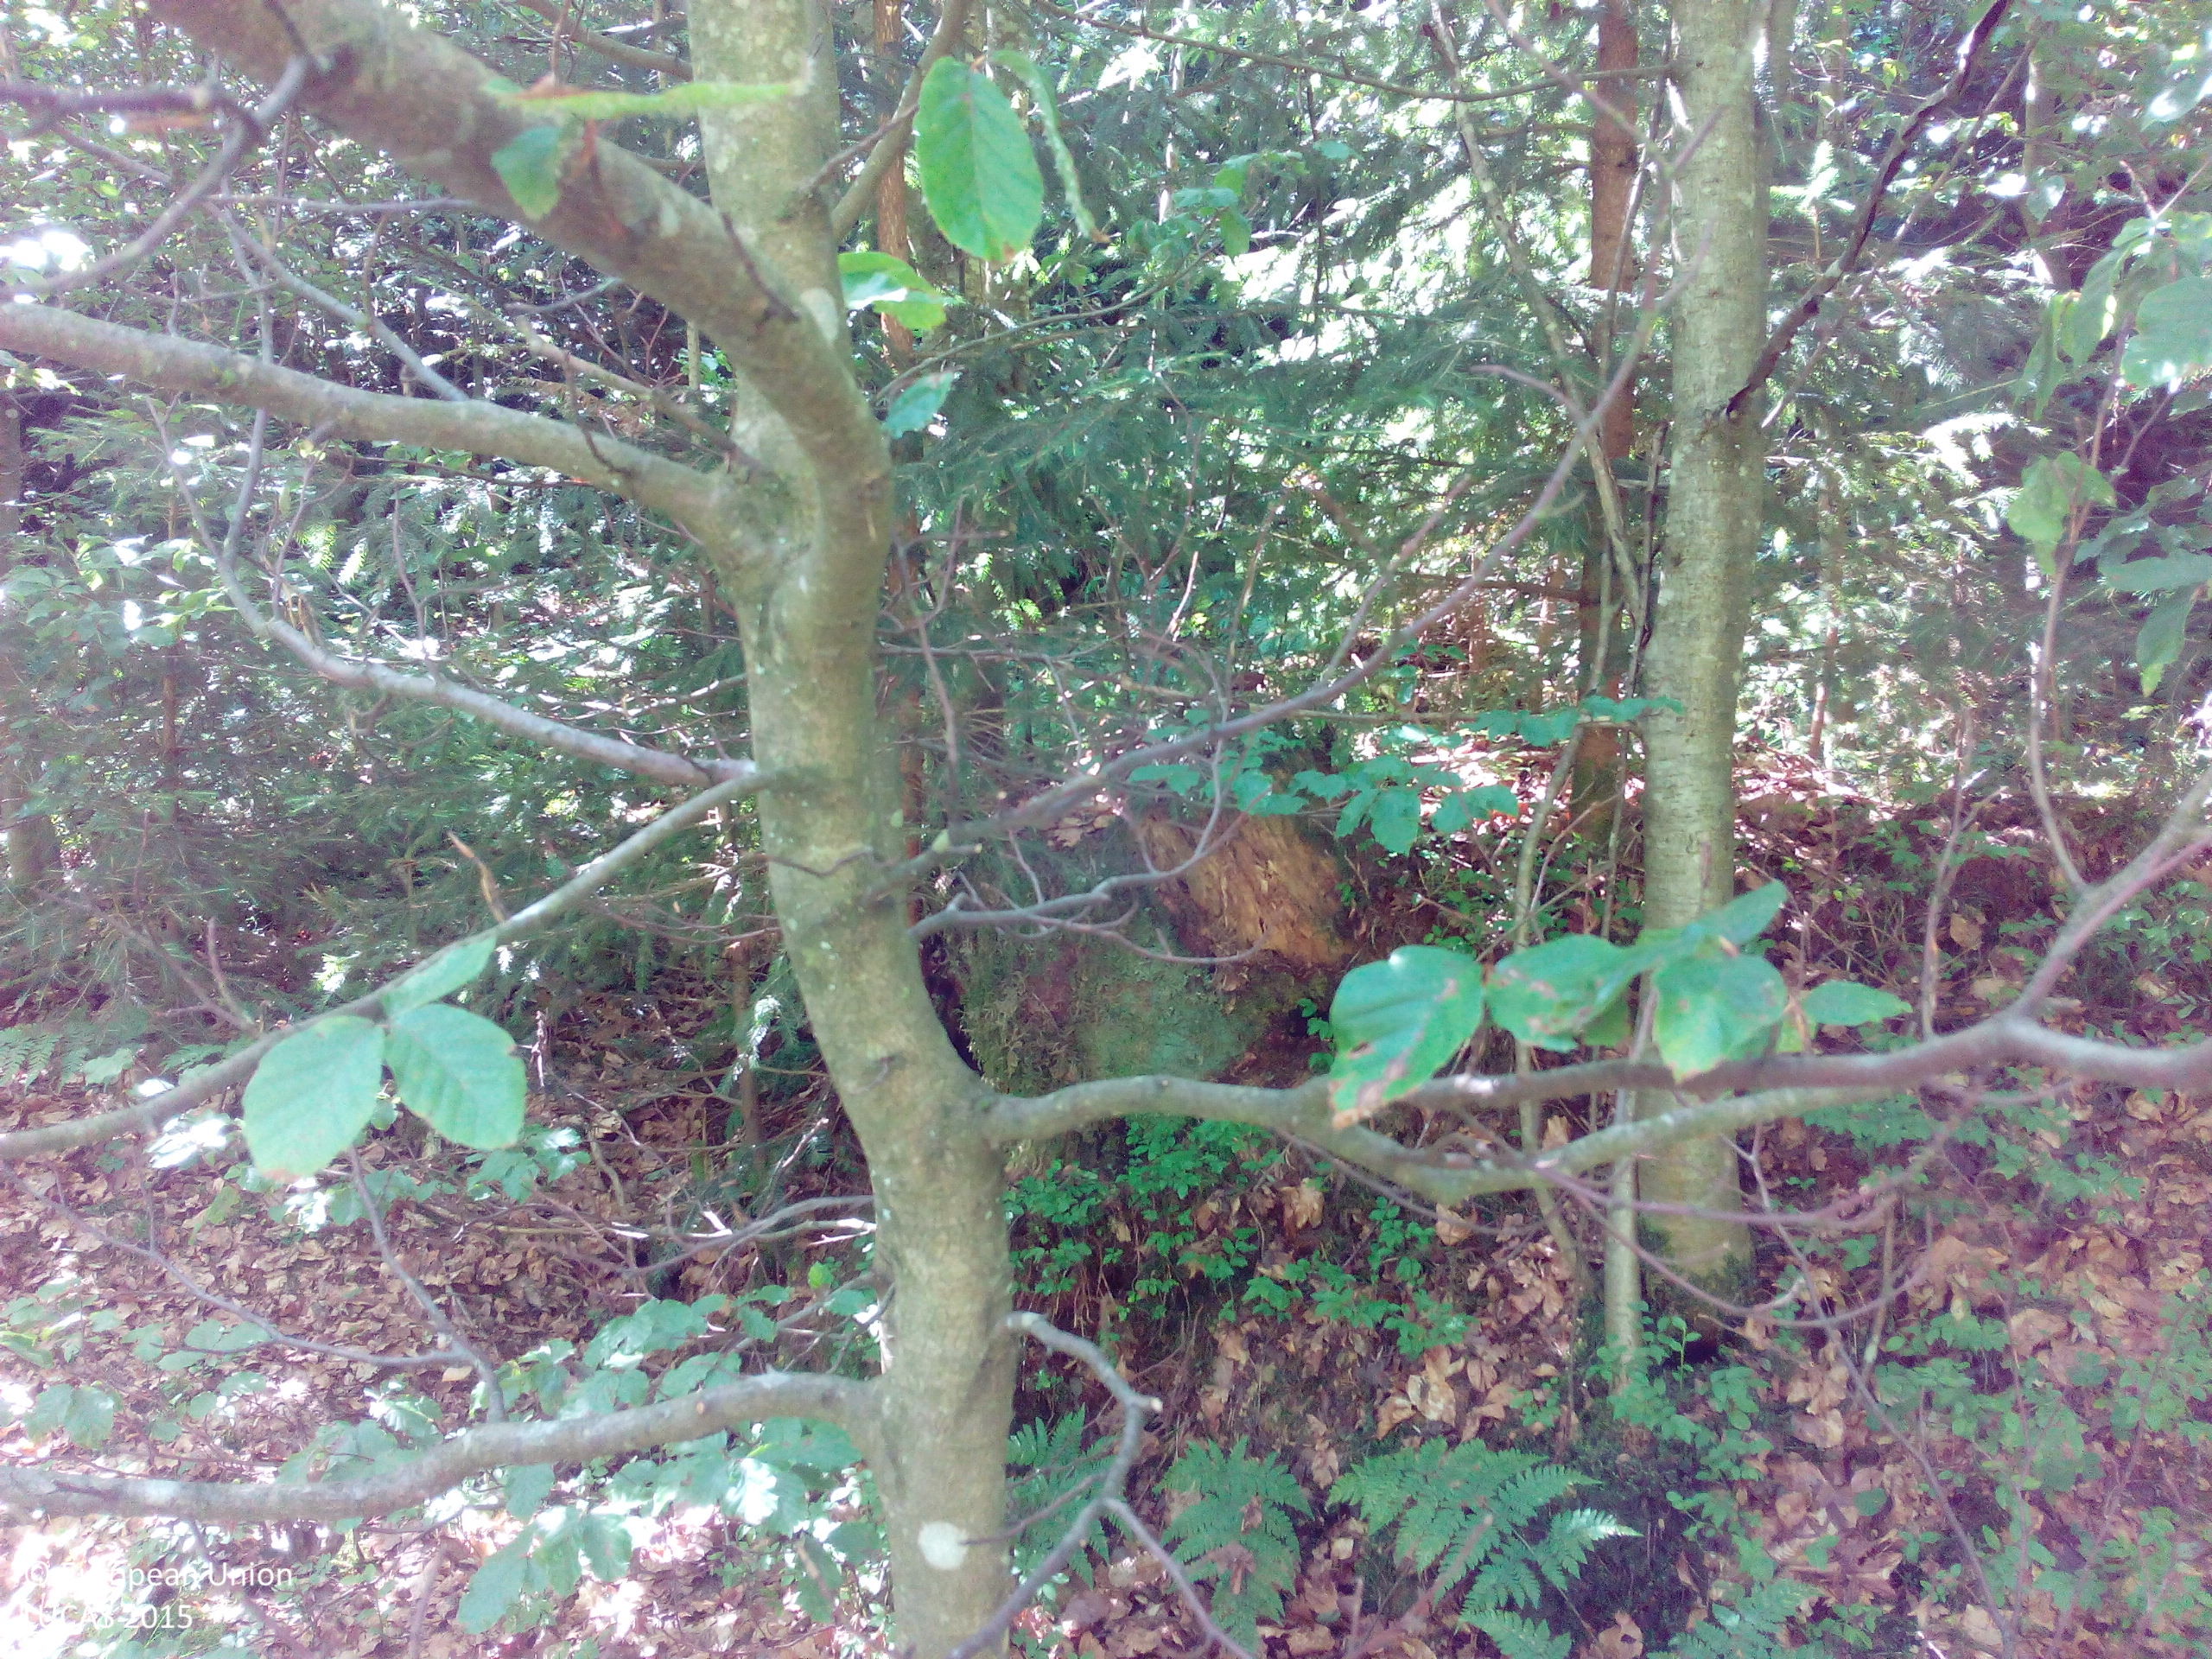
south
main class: Woodland
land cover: Other mixed woodland
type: beech forest
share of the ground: 50 - 75 %
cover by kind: broadleaved forest trees 40 %, coniferous forest trees 30 %, shrubs 10 %, unconsolidated bare surface 10 %, herbaceous plants 5 %, lichens and mosses 5 %
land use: Forestry
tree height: > 5 m
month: August
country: DE
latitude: 47.9743
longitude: 8.1659
